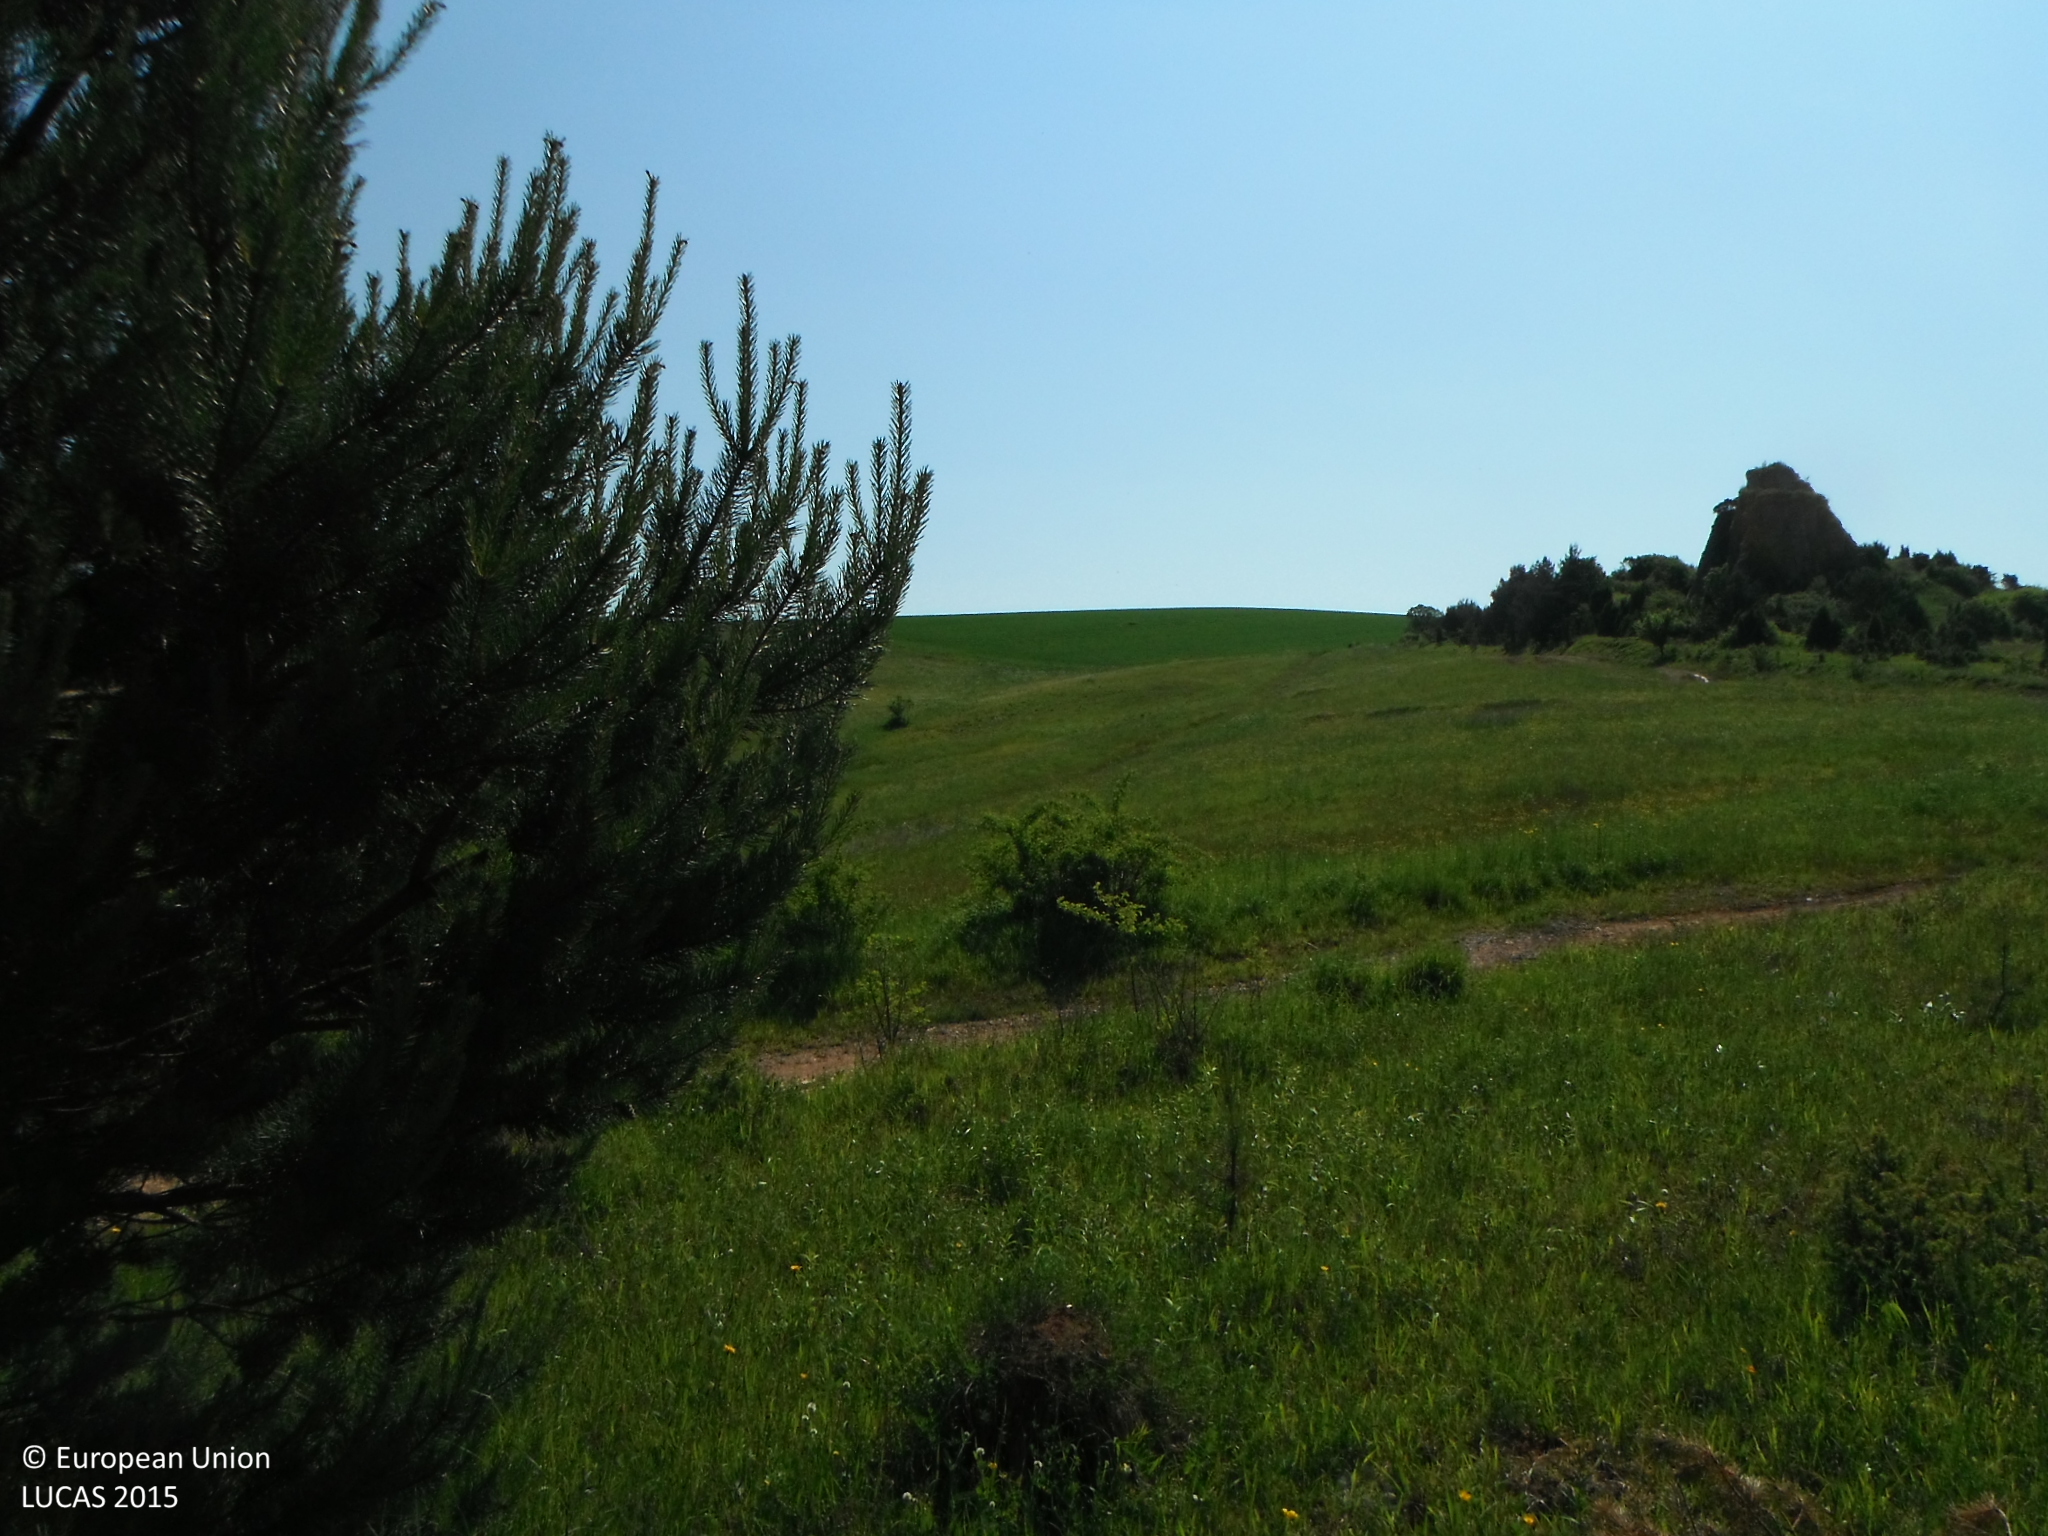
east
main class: Woodland
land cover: Pine dominated coniferous woodland
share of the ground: 10 - 25 %
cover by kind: herbaceous plants 80 %, coniferous forest trees 20 %
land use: Semi-natural and natural areas not in use
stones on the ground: 10 - 25 %
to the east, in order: Pine dominated coniferous woodland; Grassland without tree/shrub cover; Tracks; Grassland without tree/shrub cover
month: June
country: SK
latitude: 49.2880
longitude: 20.8052
